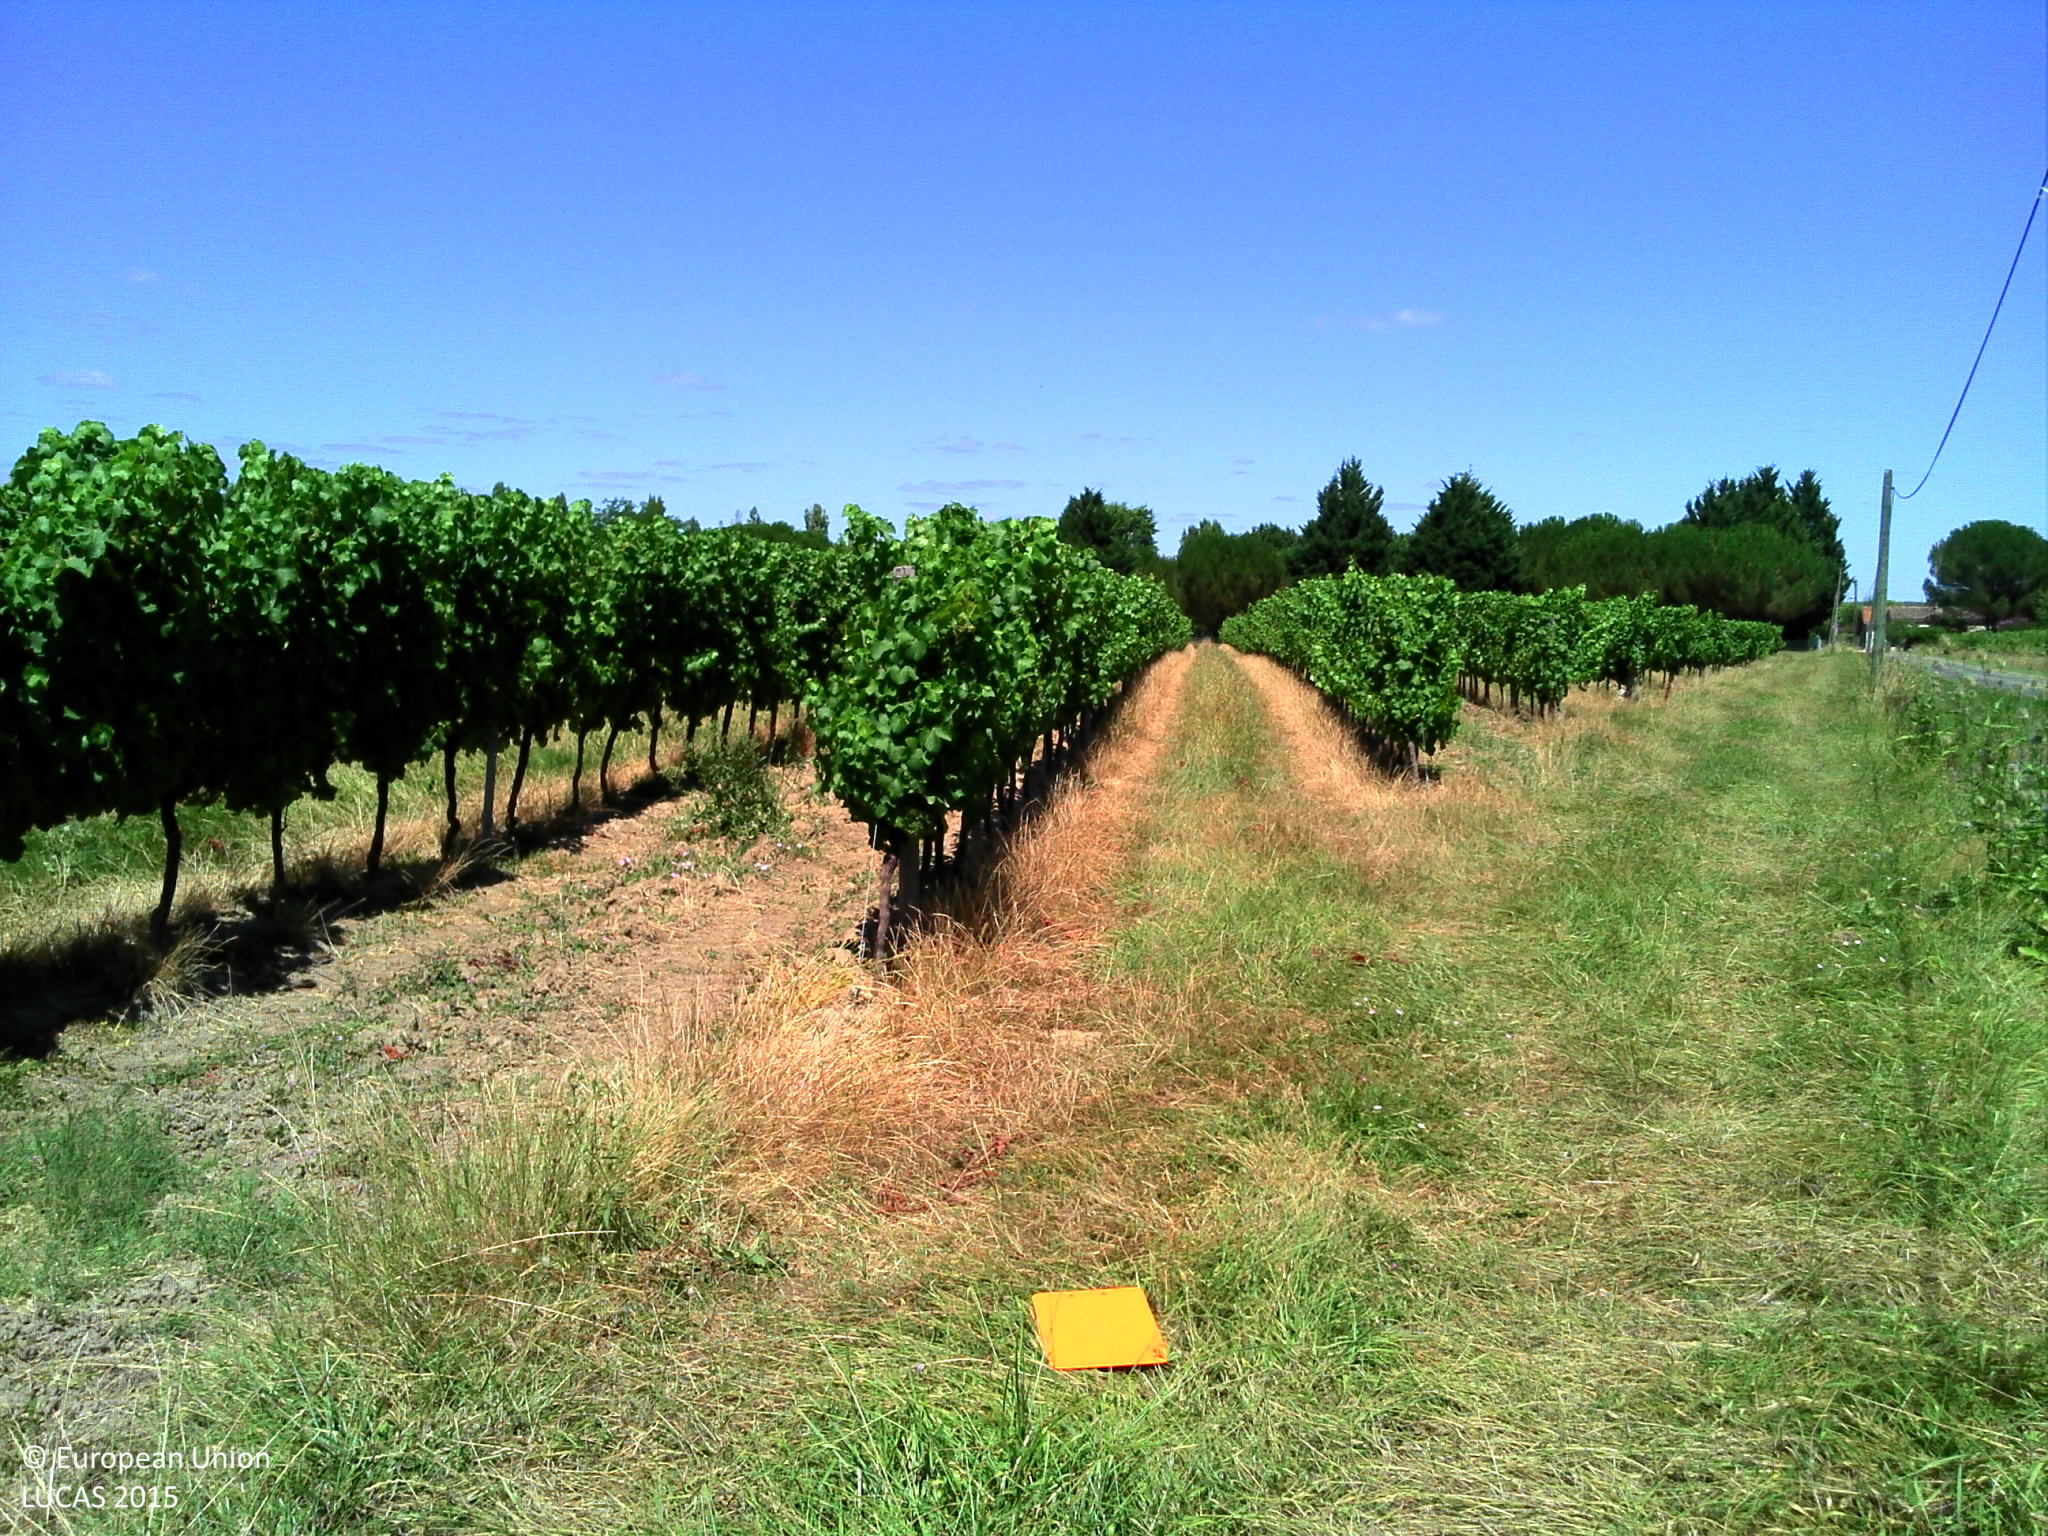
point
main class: Cropland
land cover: Vineyards
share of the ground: 25 - 50 %
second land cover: Grassland without tree/shrub cover
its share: > 75 %
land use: Agriculture (excluding fallow land and kitchen gardens)
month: July
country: FR
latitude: 44.8049
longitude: 0.5210
